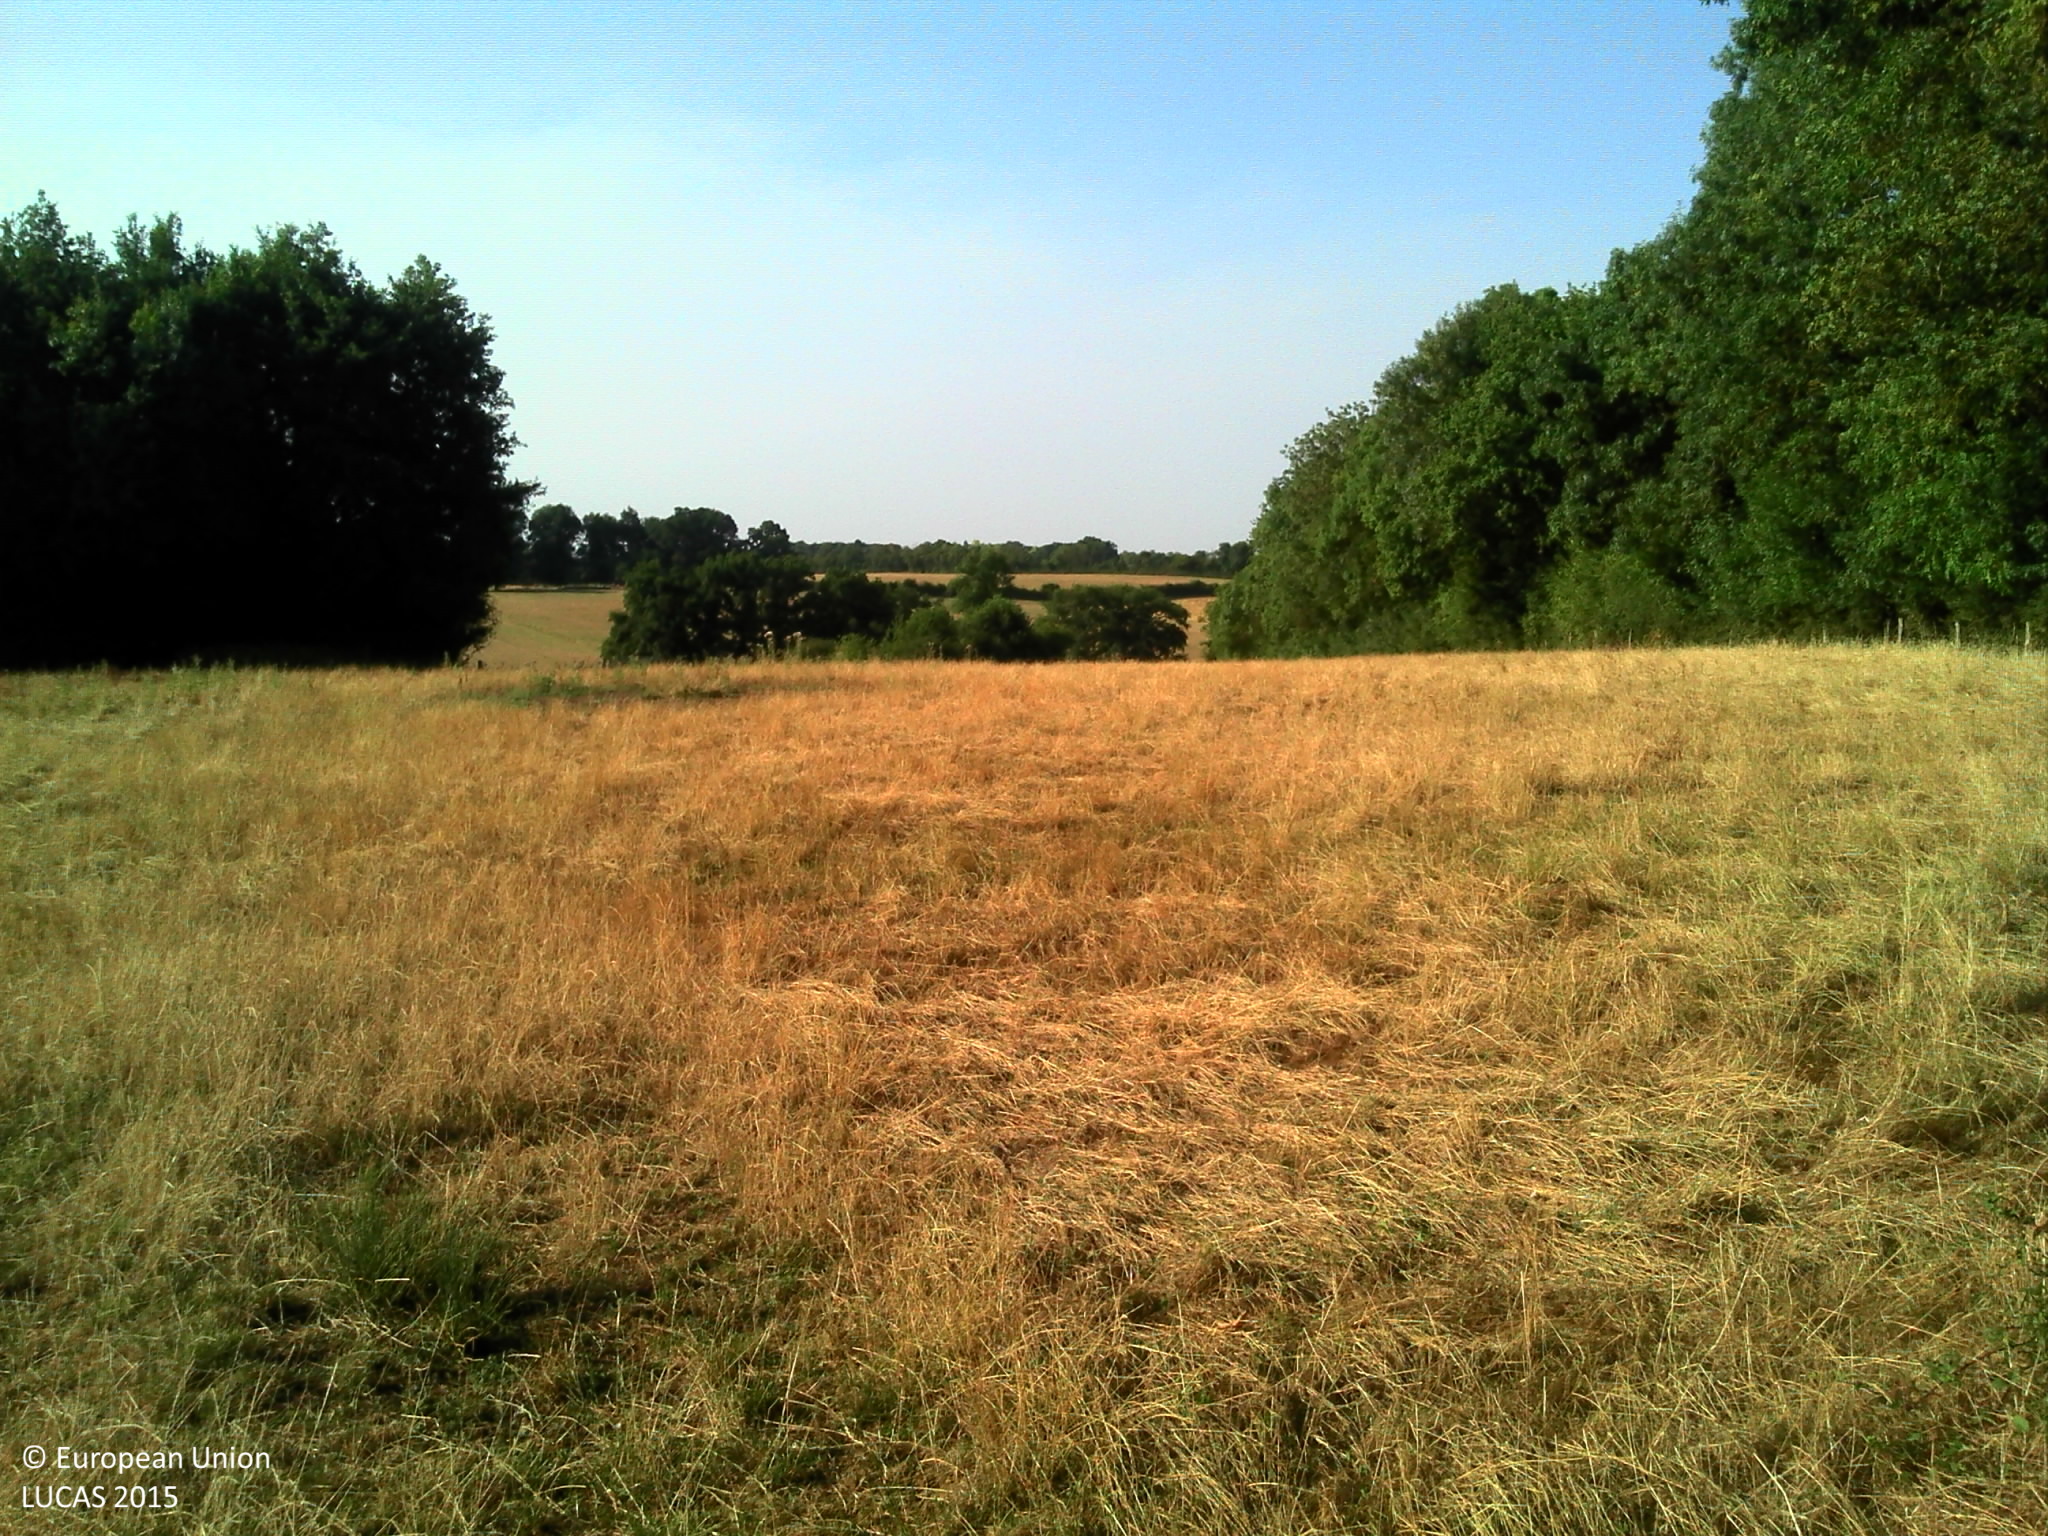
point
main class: Grassland
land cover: Grassland without tree/shrub cover
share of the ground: > 75 %
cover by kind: herbaceous plants 100 %
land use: Agriculture (excluding fallow land and kitchen gardens)
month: July
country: FR
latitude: 46.2676
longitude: 0.6557
